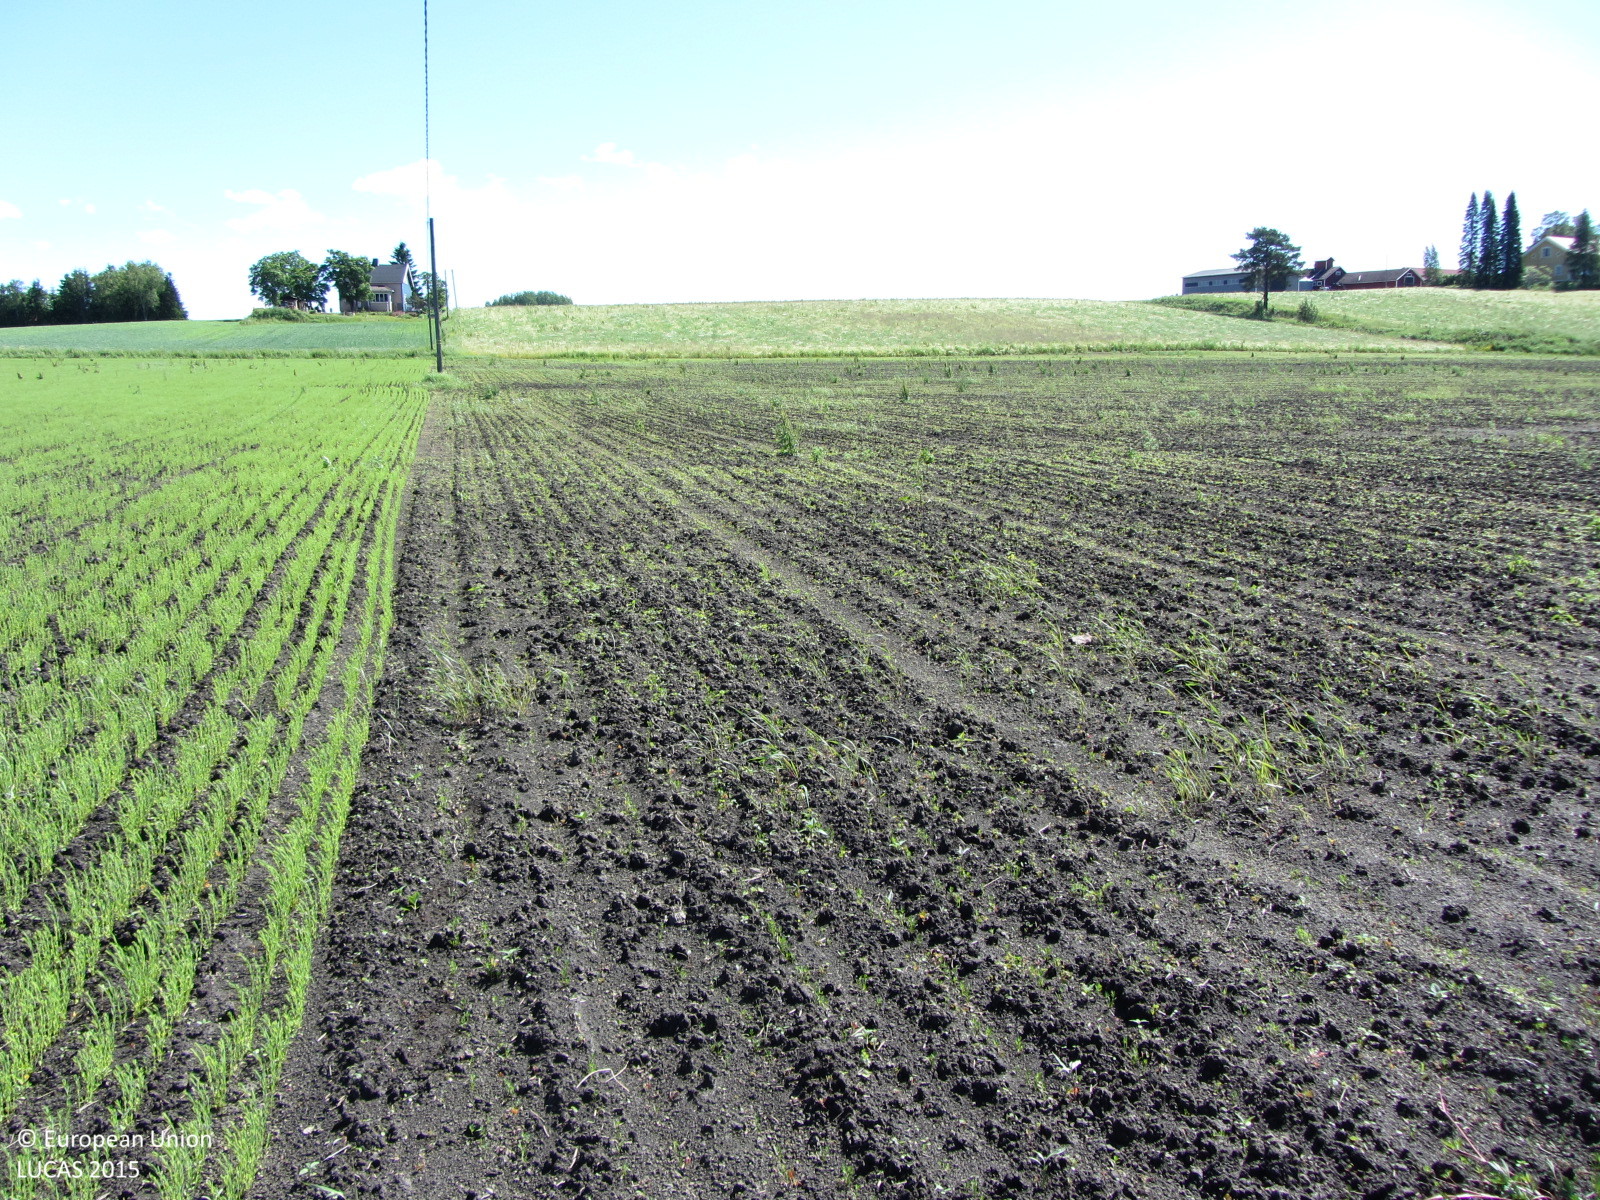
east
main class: Cropland
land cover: Other non-permanent industrial crops
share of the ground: 25 - 50 %
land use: Agriculture (excluding fallow land and kitchen gardens)
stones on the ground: < 10 %
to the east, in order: Other non-permanent industrial crops; Ditches and canals; Grass margins; Barley; Grassland with sparse tree/shrub cover; Artificial constructions in urban areas; Grassland with sparse tree/shrub cover; Managed hedges; Grass margins; Ditches and canals; Paved roads, cycling and walking lanes; Grass margins; Ditches and canals; Grass margins; Sugar beet
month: June
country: FI
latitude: 60.3383
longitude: 23.2533
